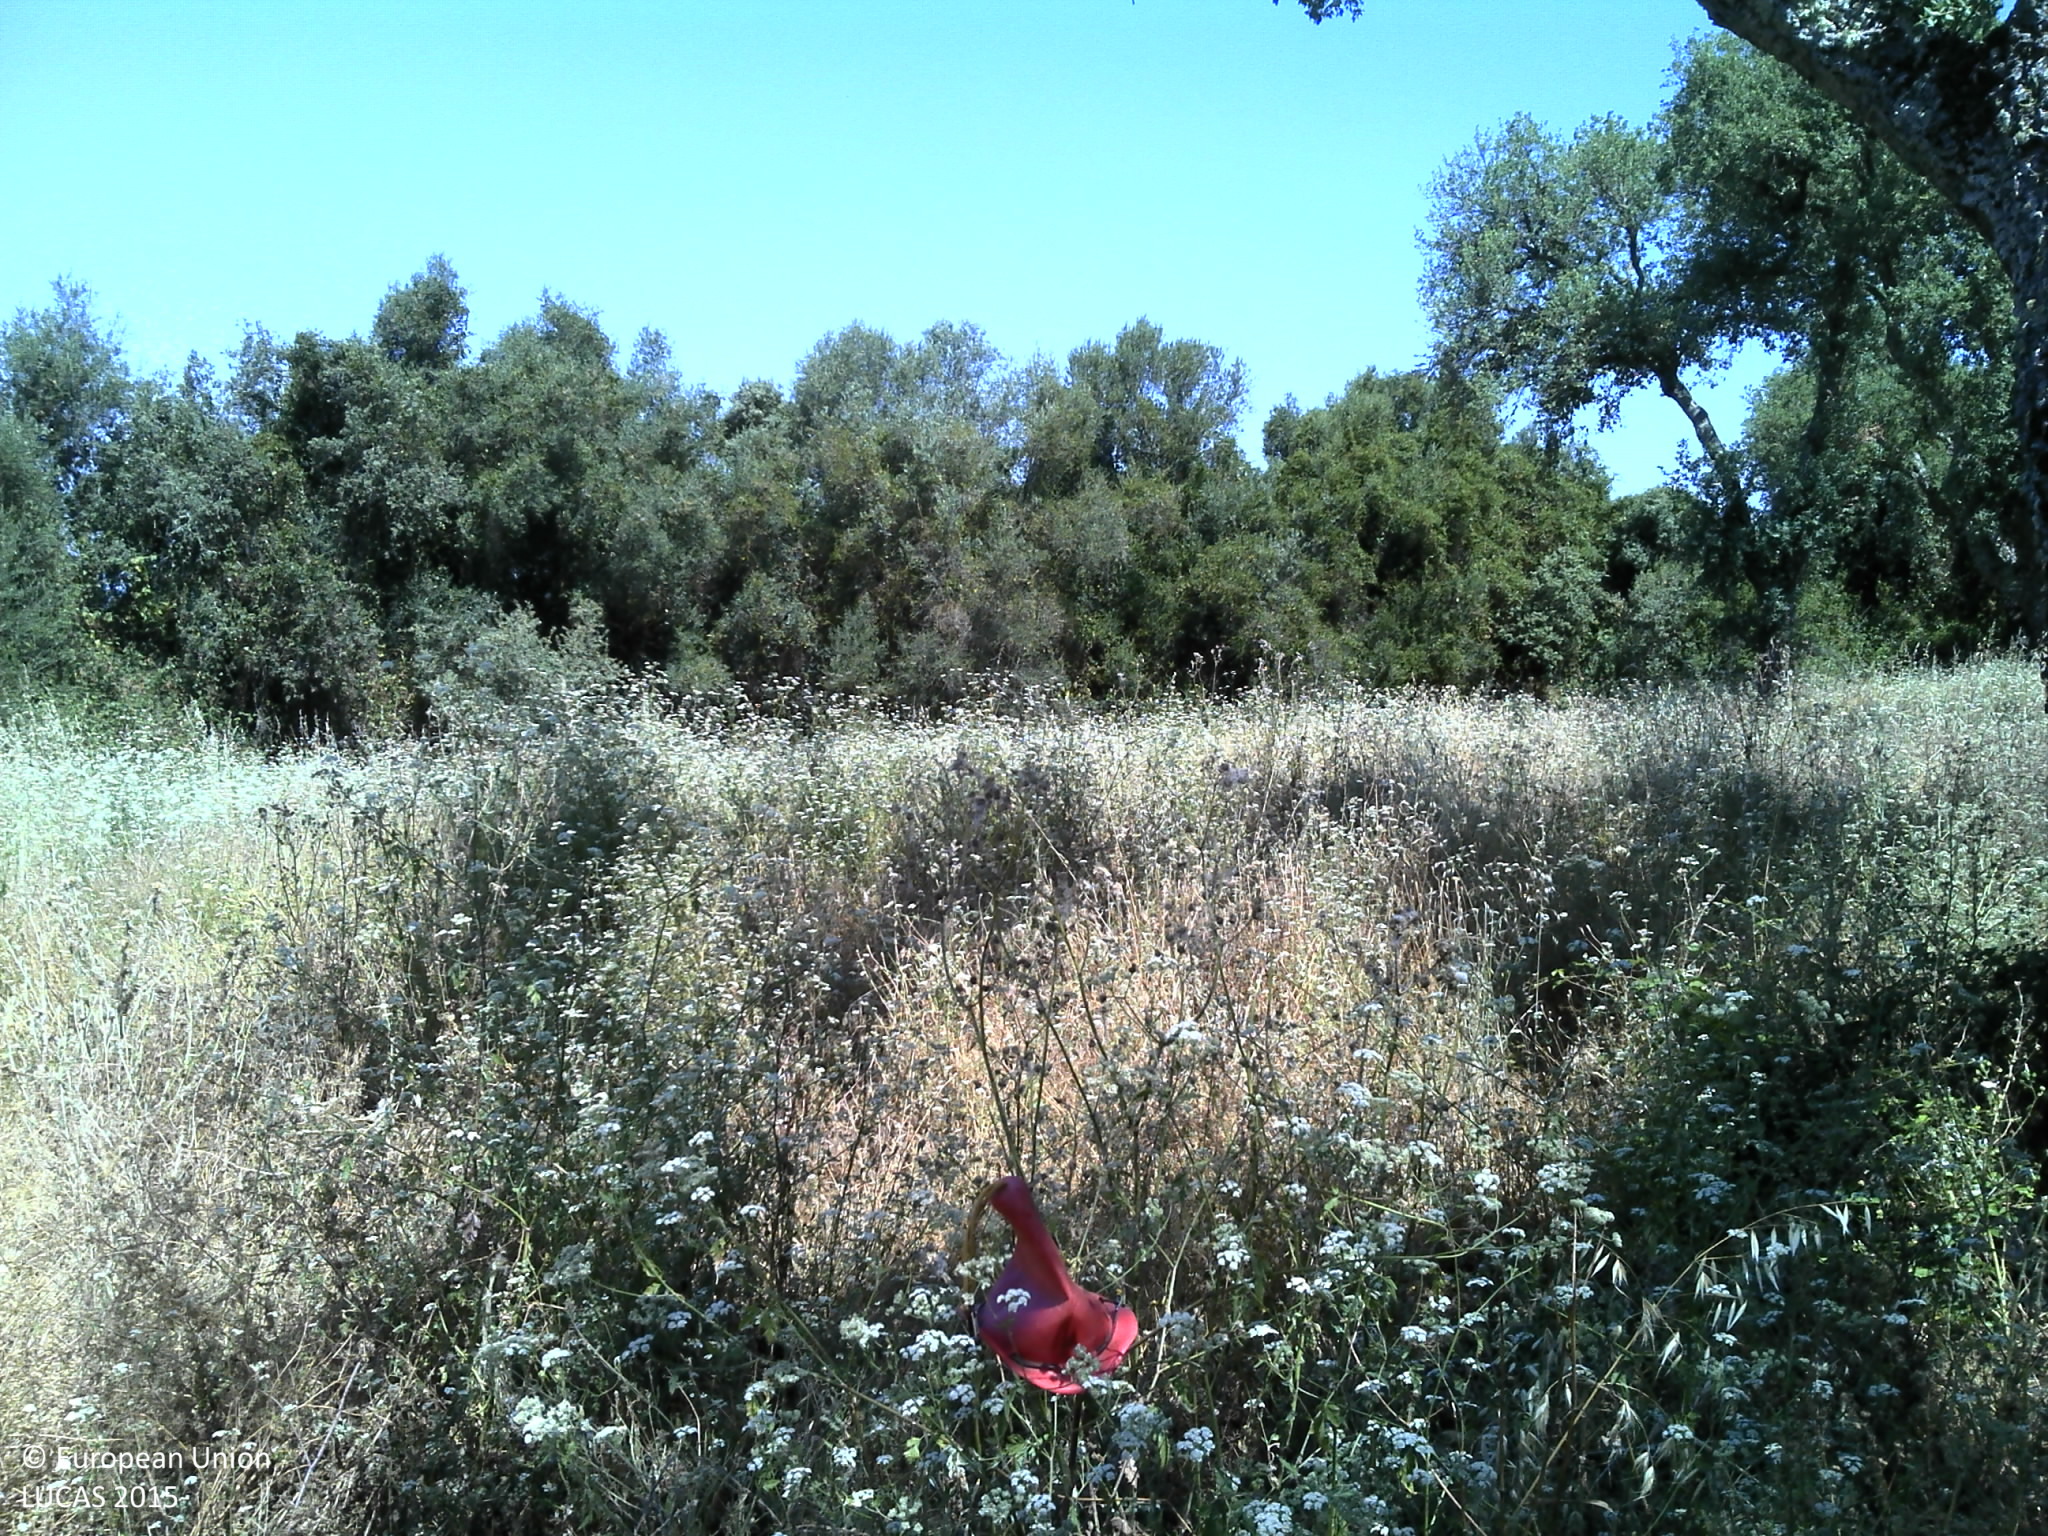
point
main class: Woodland
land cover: Broadleaved woodland
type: broadleaved evergreen forest
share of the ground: > 75 %
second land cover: Grassland without tree/shrub cover
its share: > 75 %
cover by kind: broadleaved forest trees 75 %, herbaceous plants 25 %
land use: Forestry
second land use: Agriculture (excluding fallow land and kitchen gardens)
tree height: > 5 m
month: June
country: PT
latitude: 38.6210
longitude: -8.1124
